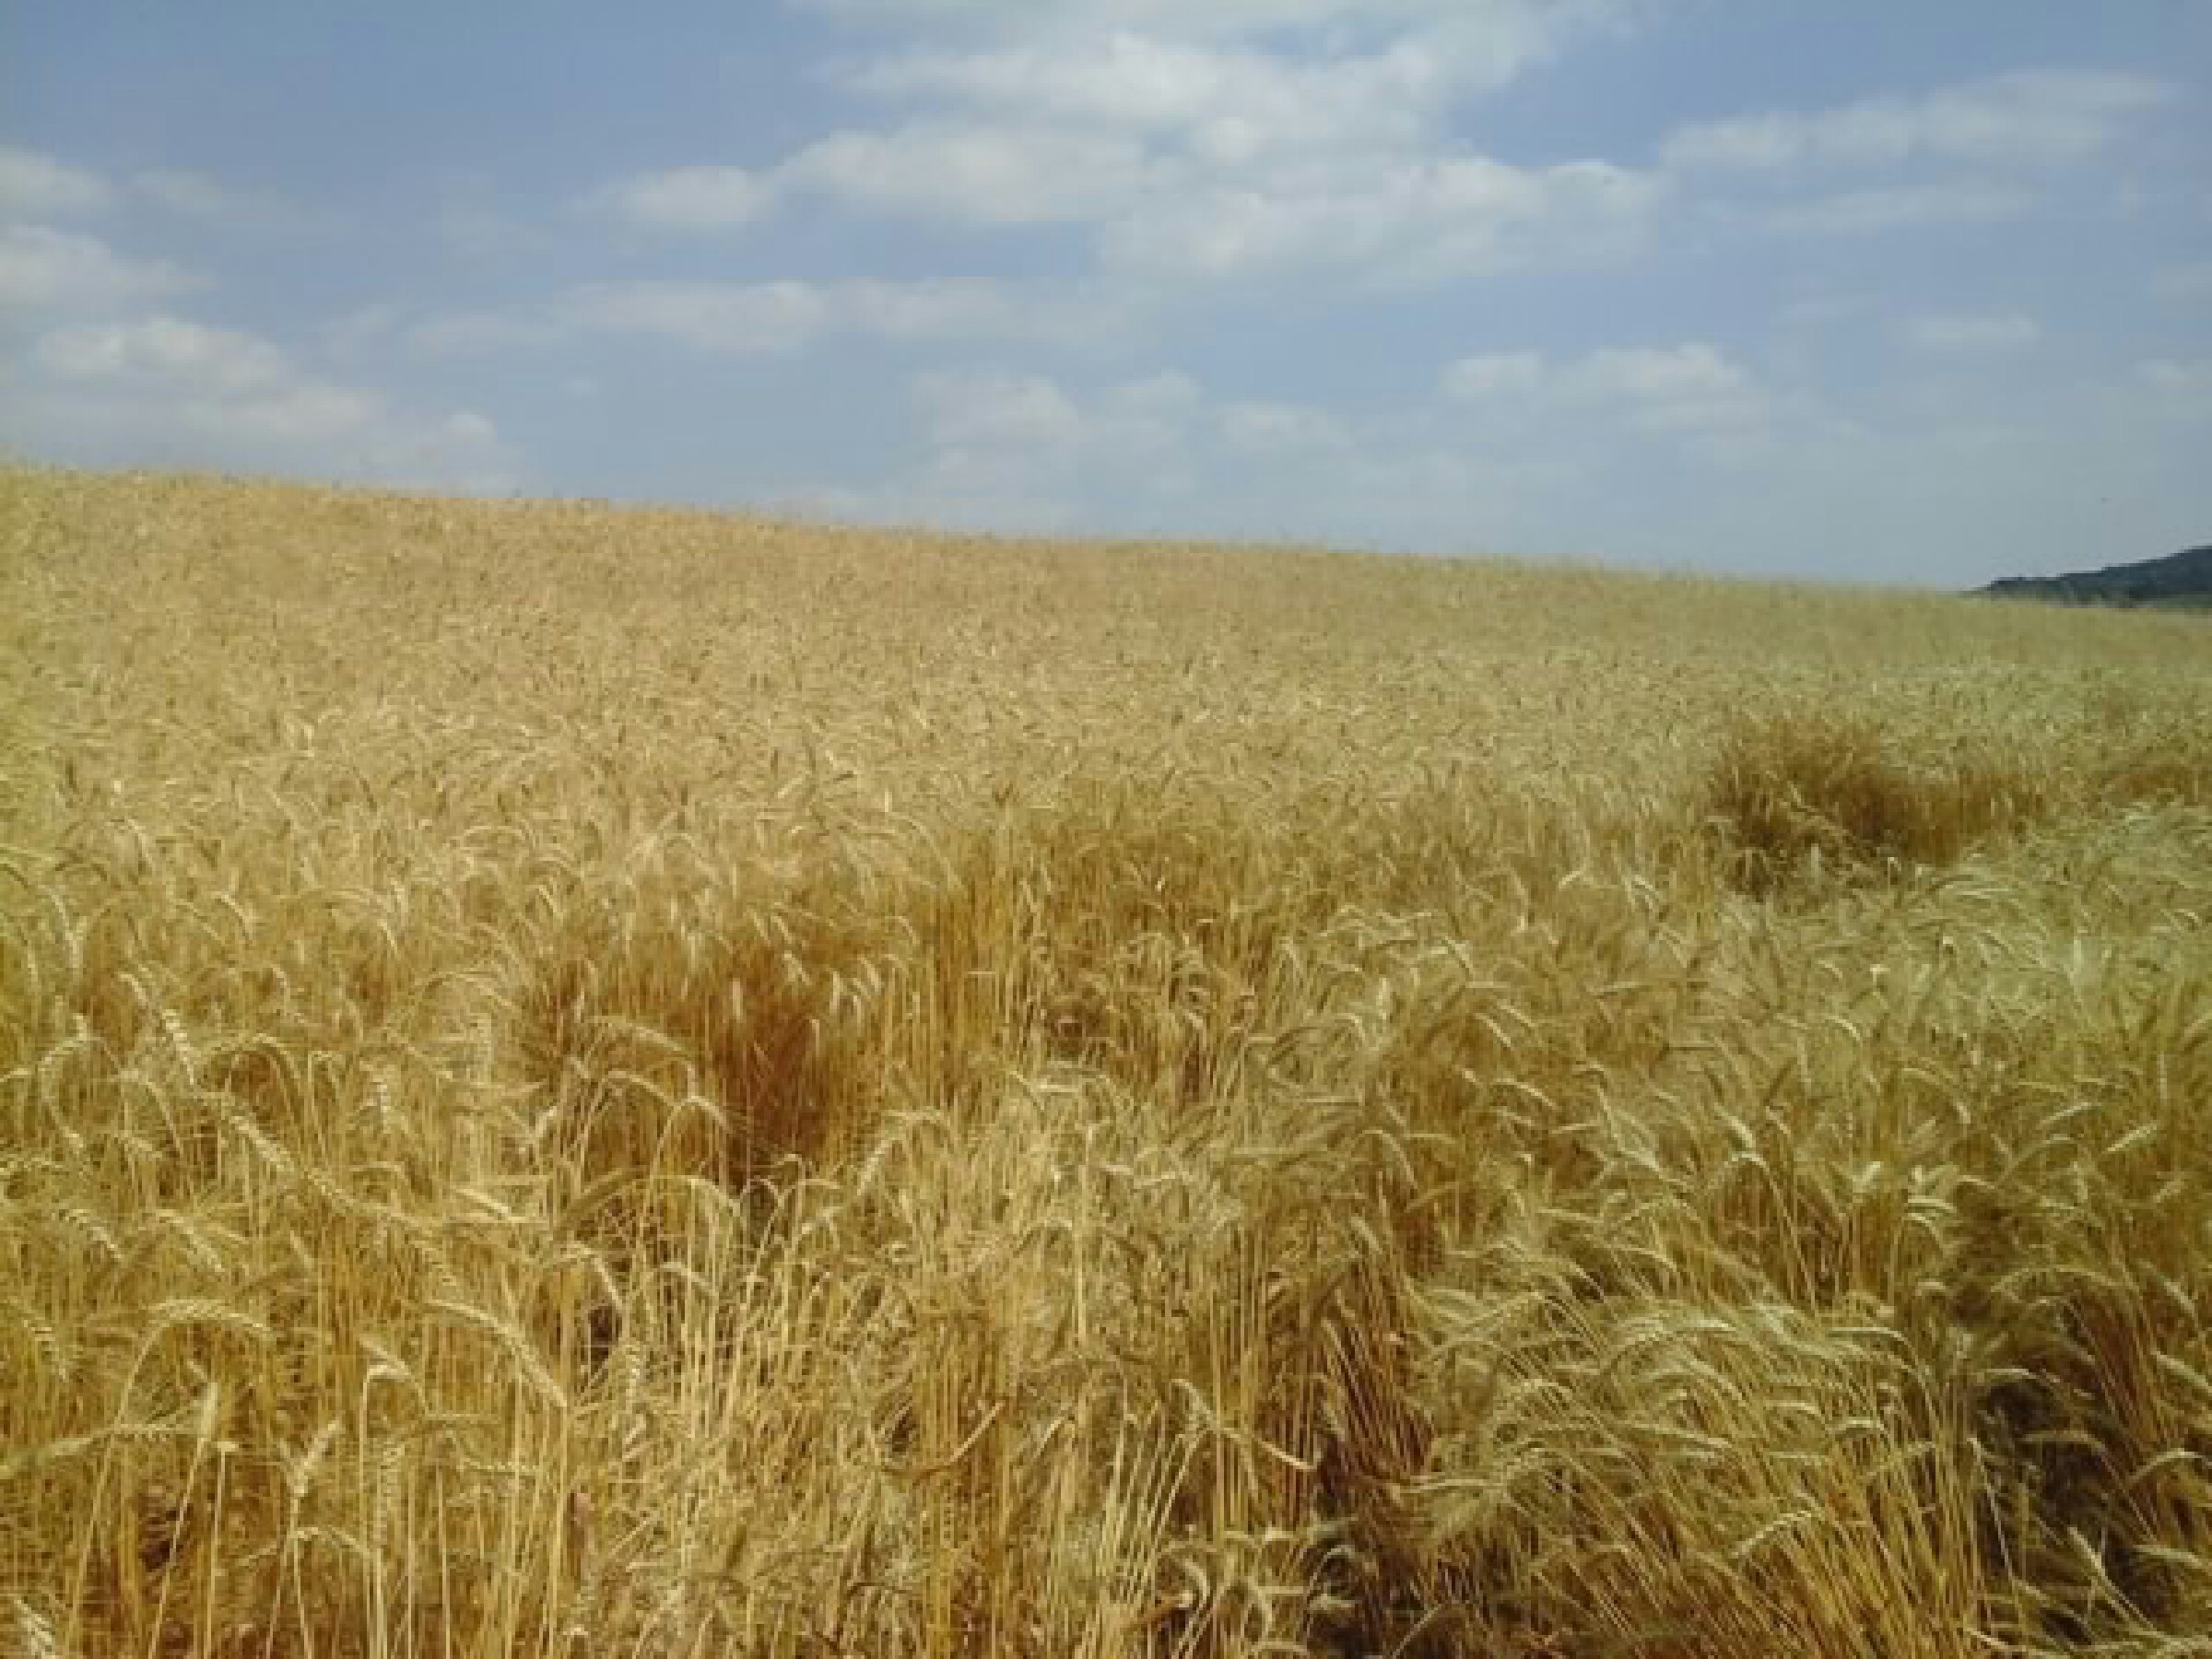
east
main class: Cropland
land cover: Common wheat
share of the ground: > 75 %
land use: Agriculture (excluding fallow land and kitchen gardens)
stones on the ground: < 10 %
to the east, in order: Common wheat
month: July
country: HU
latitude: 47.8581
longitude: 19.3915
